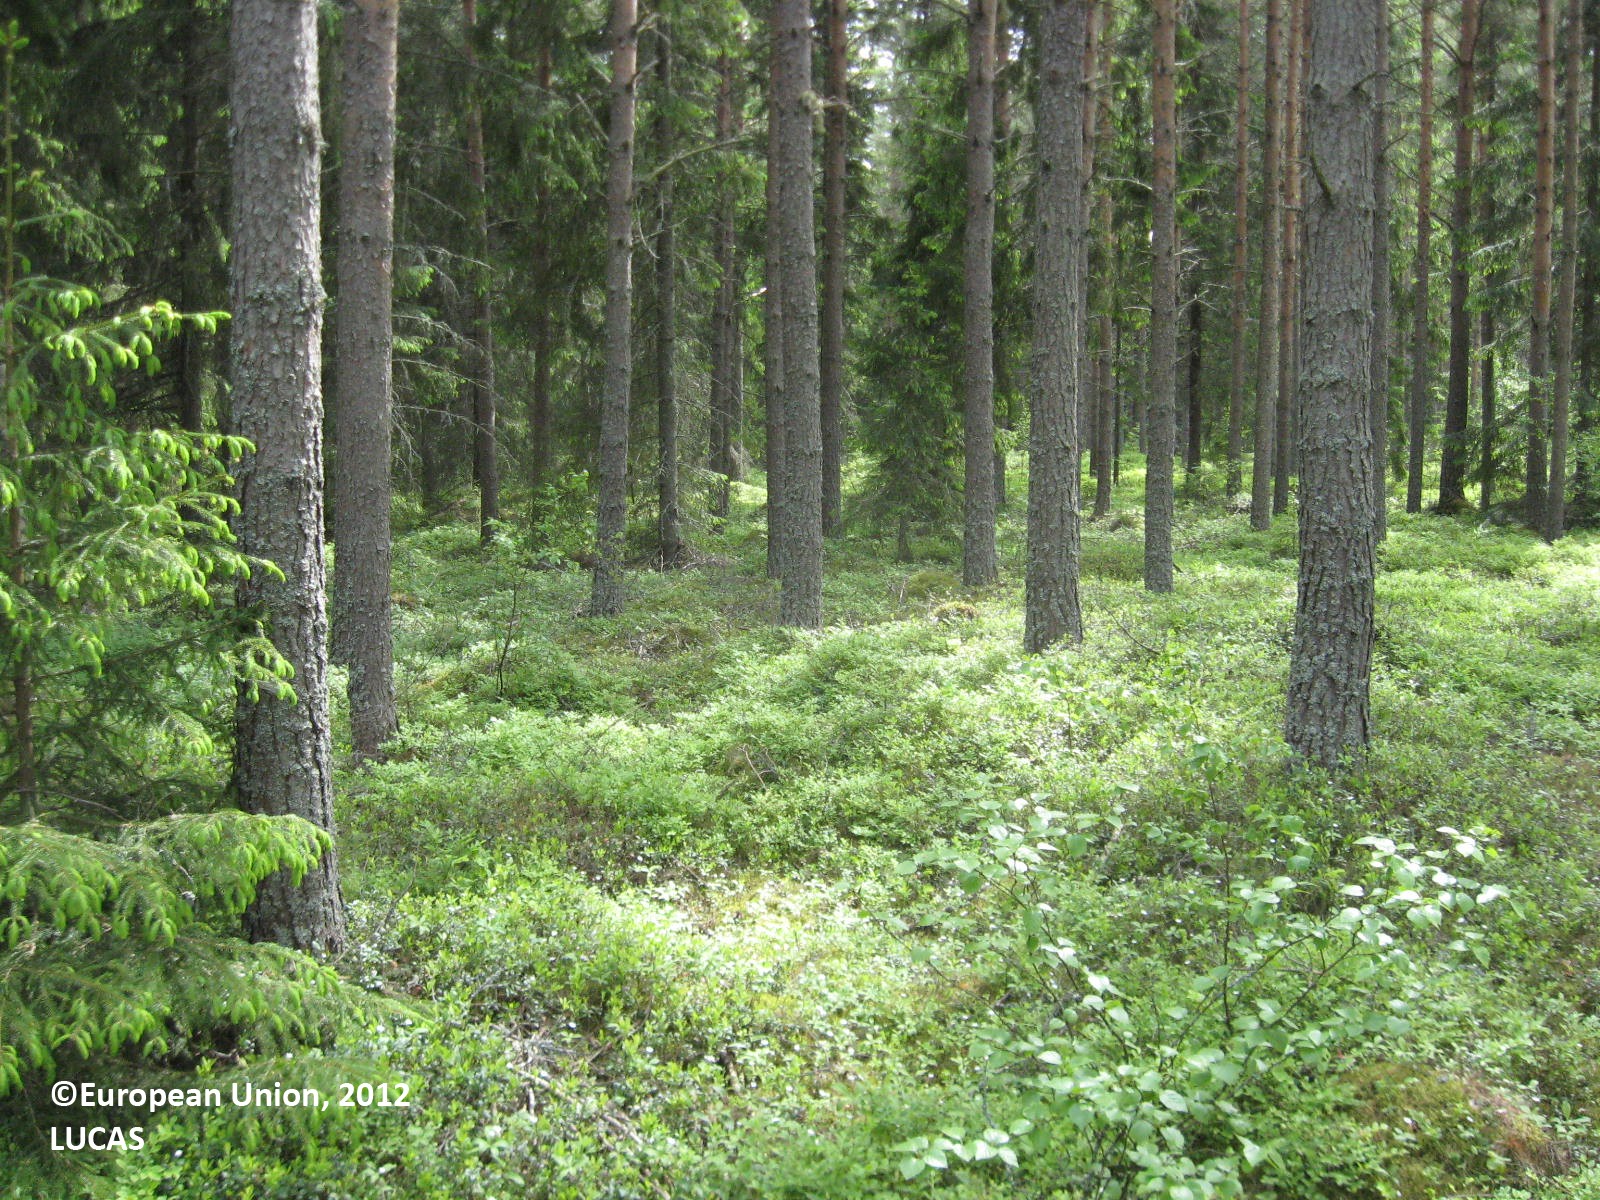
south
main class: Woodland
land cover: Other coniferous woodland
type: boreal forest
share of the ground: > 75 %
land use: Forestry
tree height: > 5 m
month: June
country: FI
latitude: 62.6388
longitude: 21.0965
